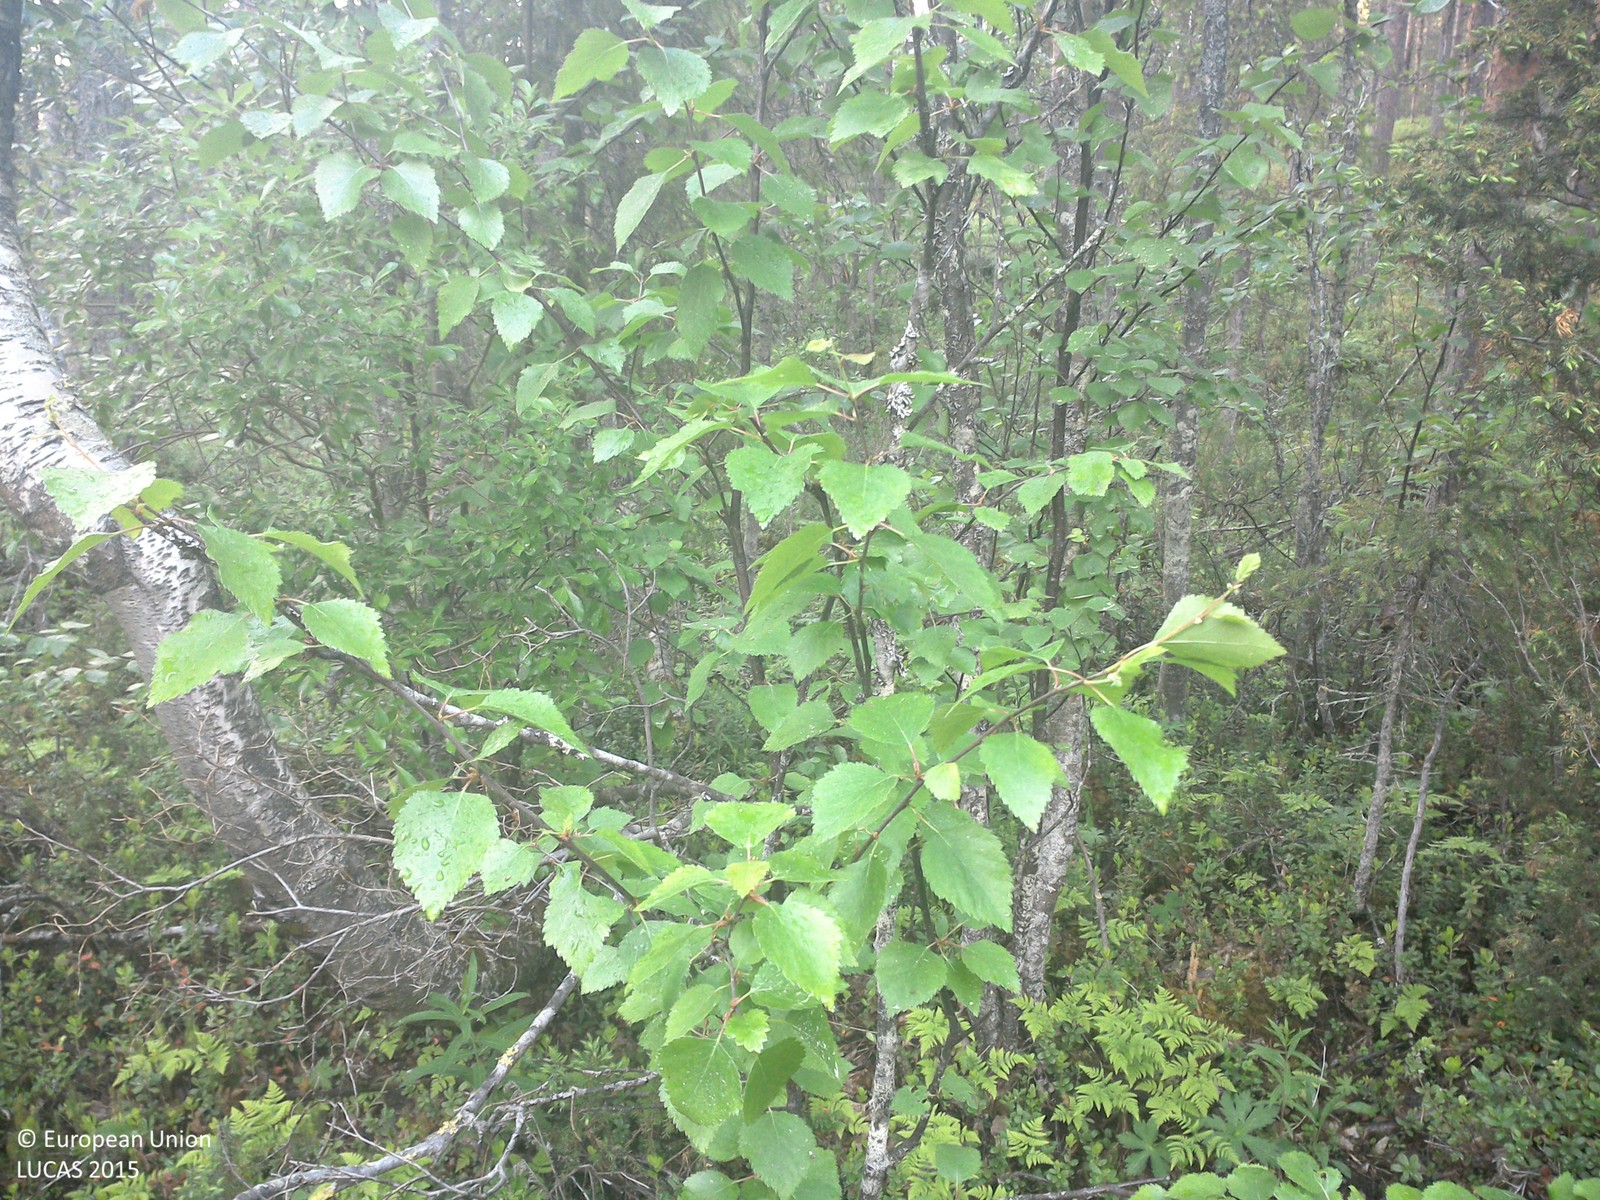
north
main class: Woodland
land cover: Pine dominated mixed woodland
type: boreal forest
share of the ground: 25 - 50 %
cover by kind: shrubs 60 %, coniferous forest trees 20 %, broadleaved forest trees 10 %, herbaceous plants 5 %, lichens and mosses 5 %
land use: Forestry
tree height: > 5 m
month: July
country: SE
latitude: 66.9184
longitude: 23.1626
